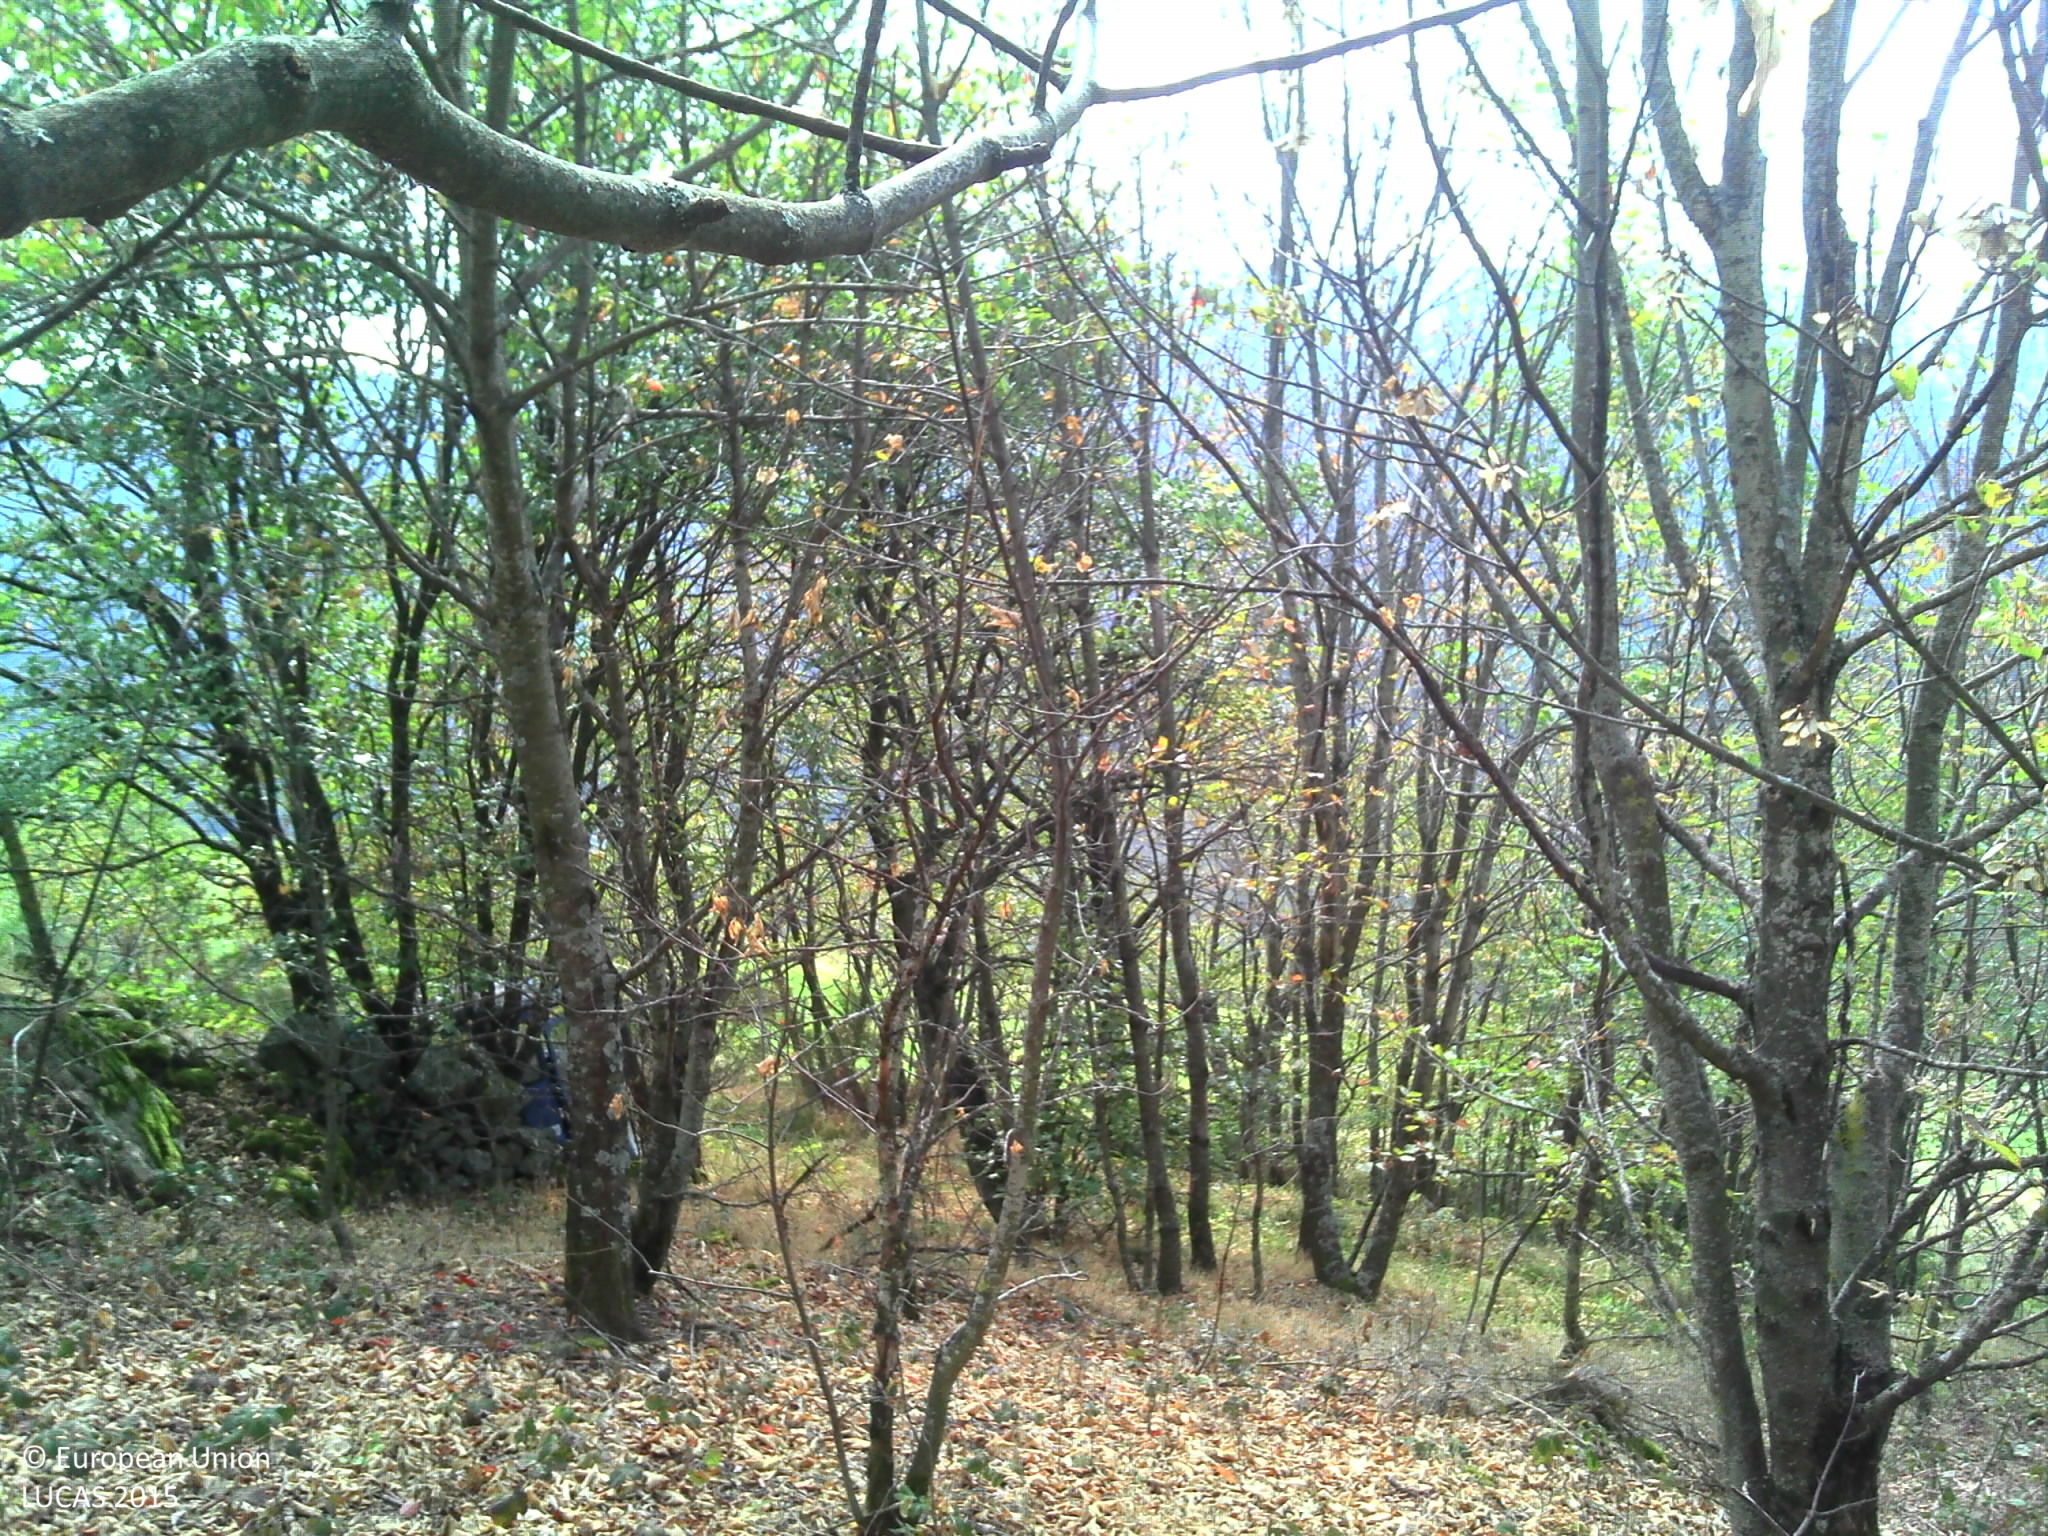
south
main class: Woodland
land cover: Broadleaved woodland
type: mesophytic deciduous forest
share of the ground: > 75 %
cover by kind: broadleaved forest trees 90 %, herbaceous plants 10 %
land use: Agriculture (excluding fallow land and kitchen gardens)
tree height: > 5 m
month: September
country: FR
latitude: 45.2906
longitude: 4.5345
